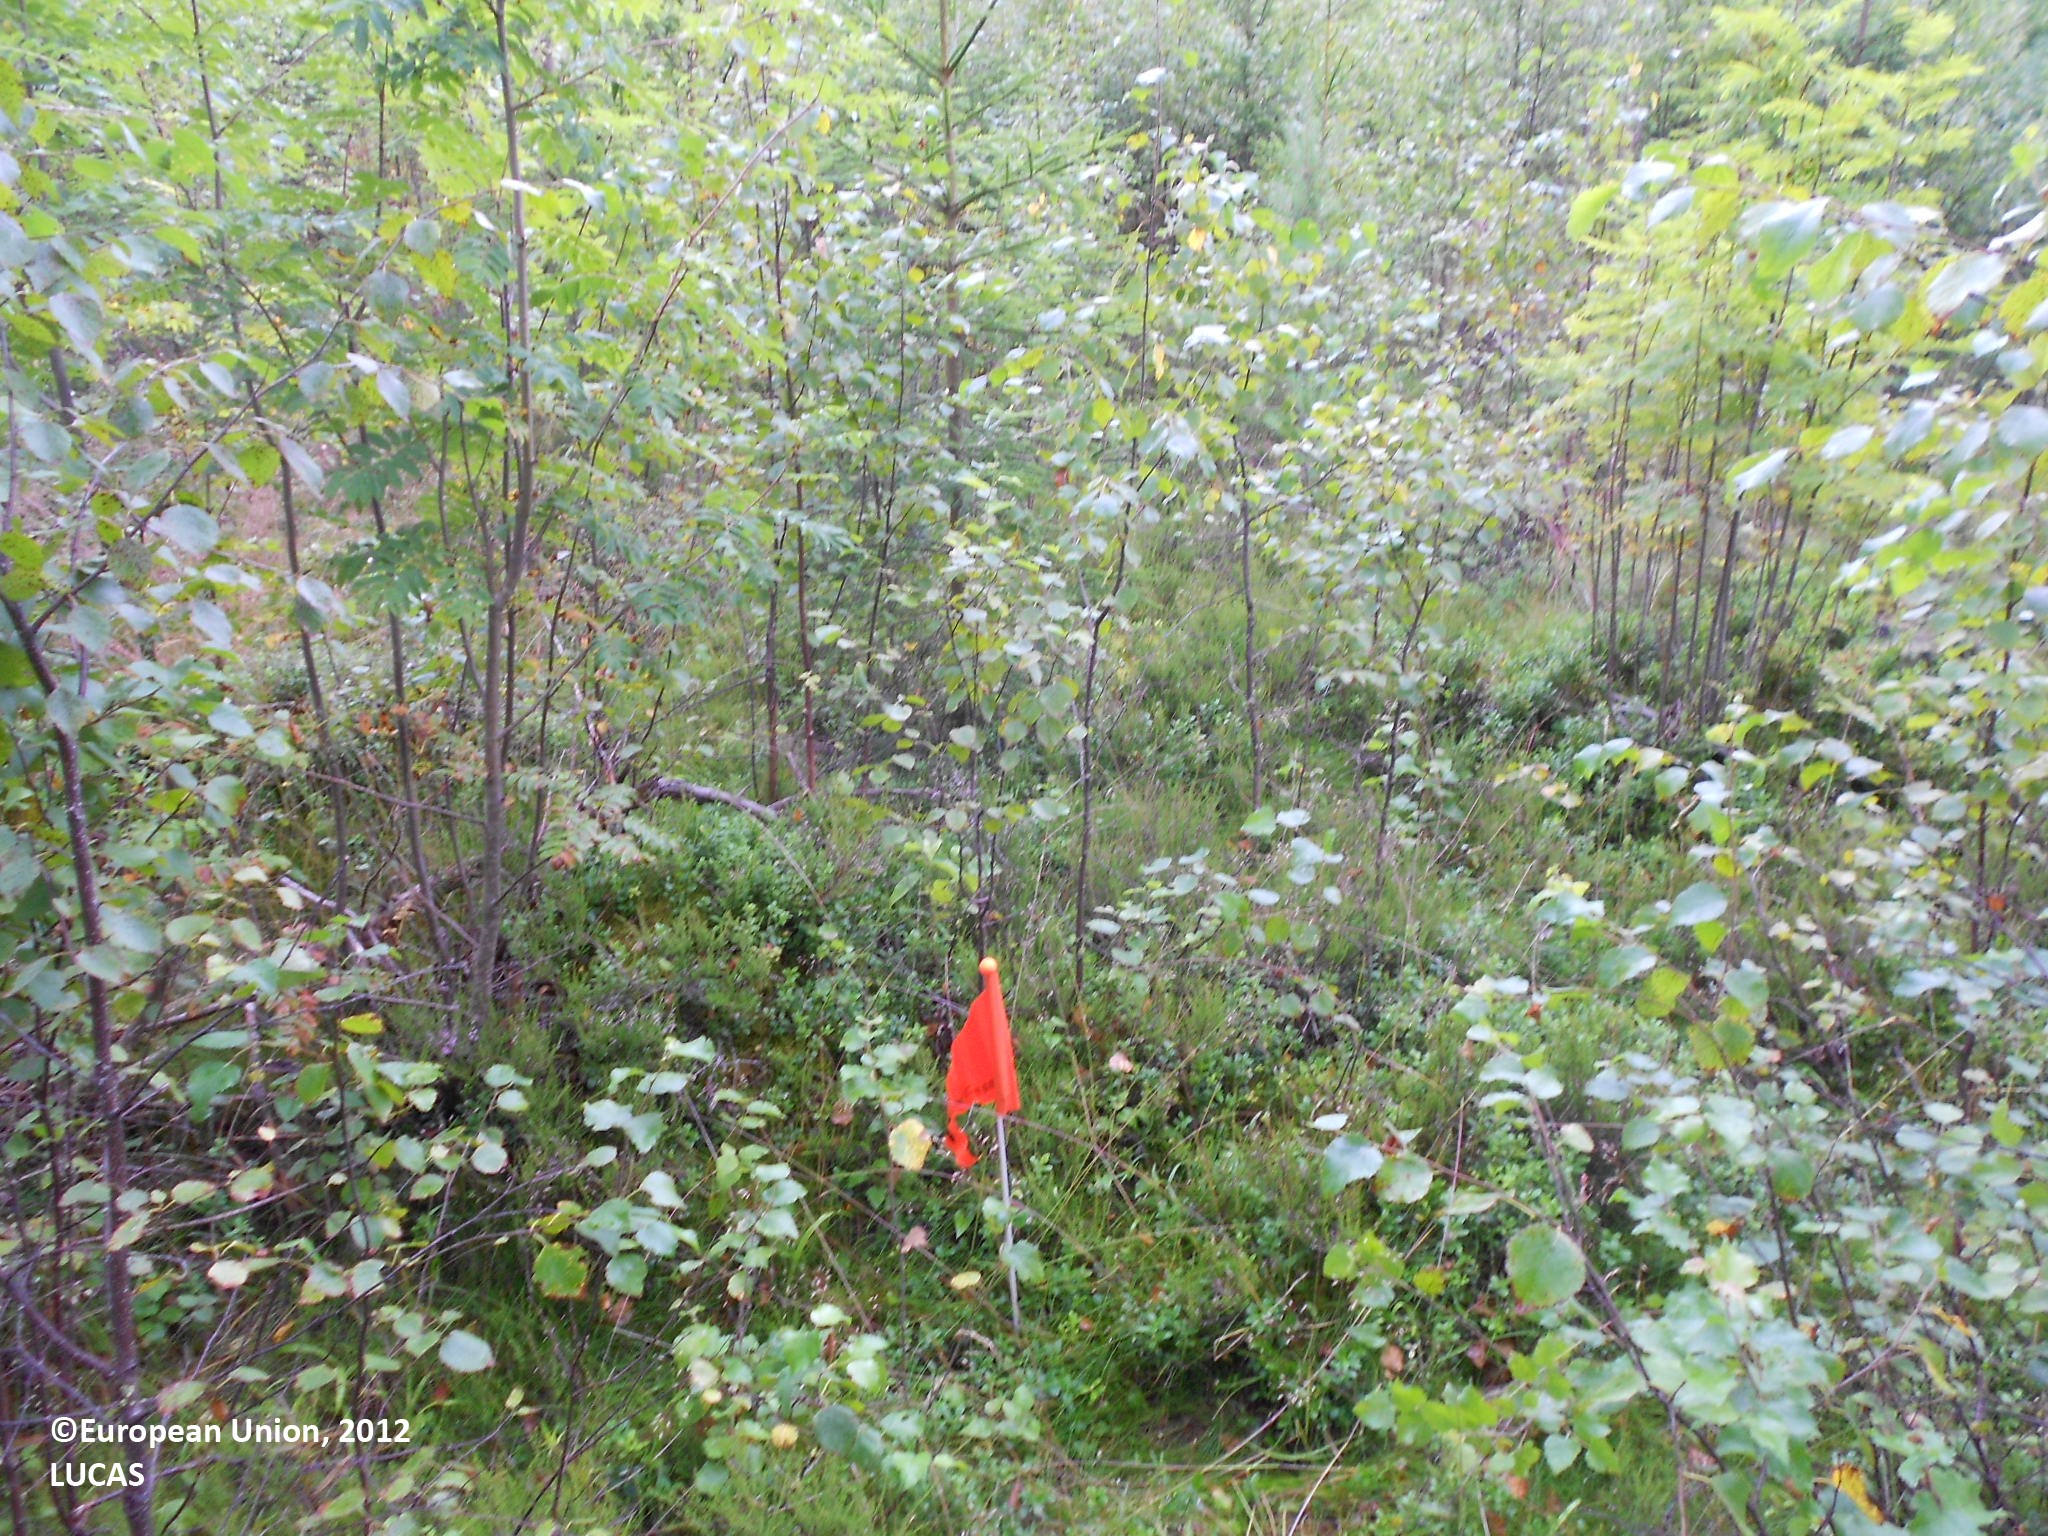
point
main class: Woodland
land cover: Spruce dominated mixed woodland
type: boreal forest
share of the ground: 50 - 75 %
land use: Forestry
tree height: < 5 m
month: August
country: FI
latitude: 63.3764
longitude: 28.7409
